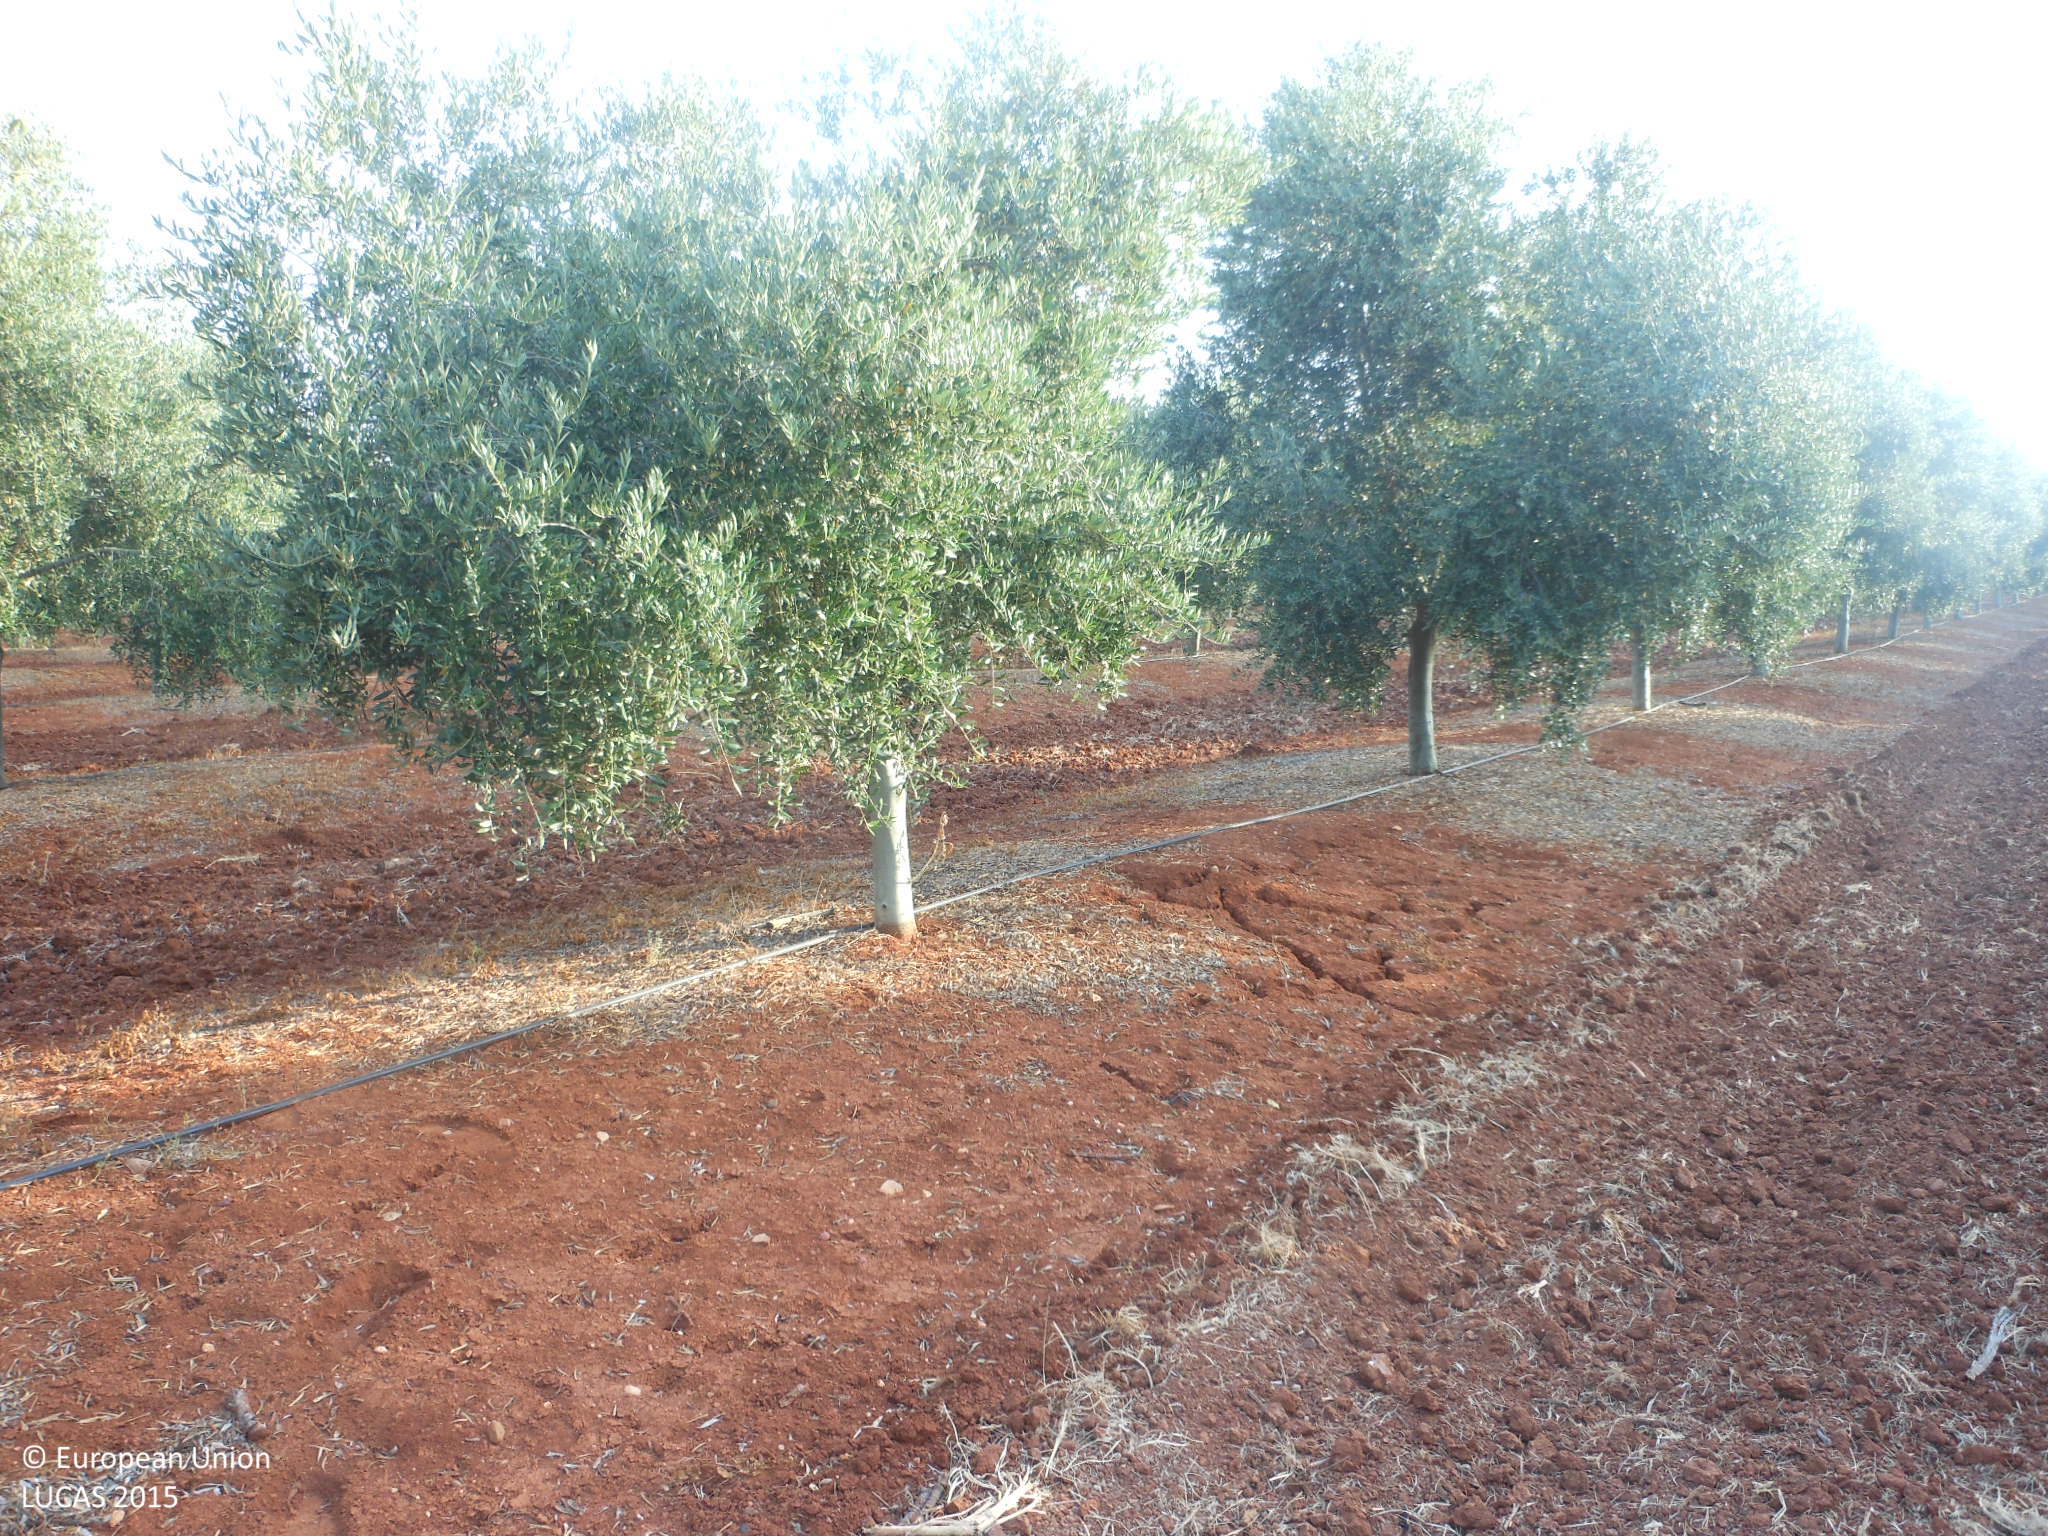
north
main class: Cropland
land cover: Olive groves
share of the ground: 25 - 50 %
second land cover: Other bare soil
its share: > 75 %
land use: Agriculture (excluding fallow land and kitchen gardens)
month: July
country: ES
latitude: 37.4825
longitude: -5.1552
